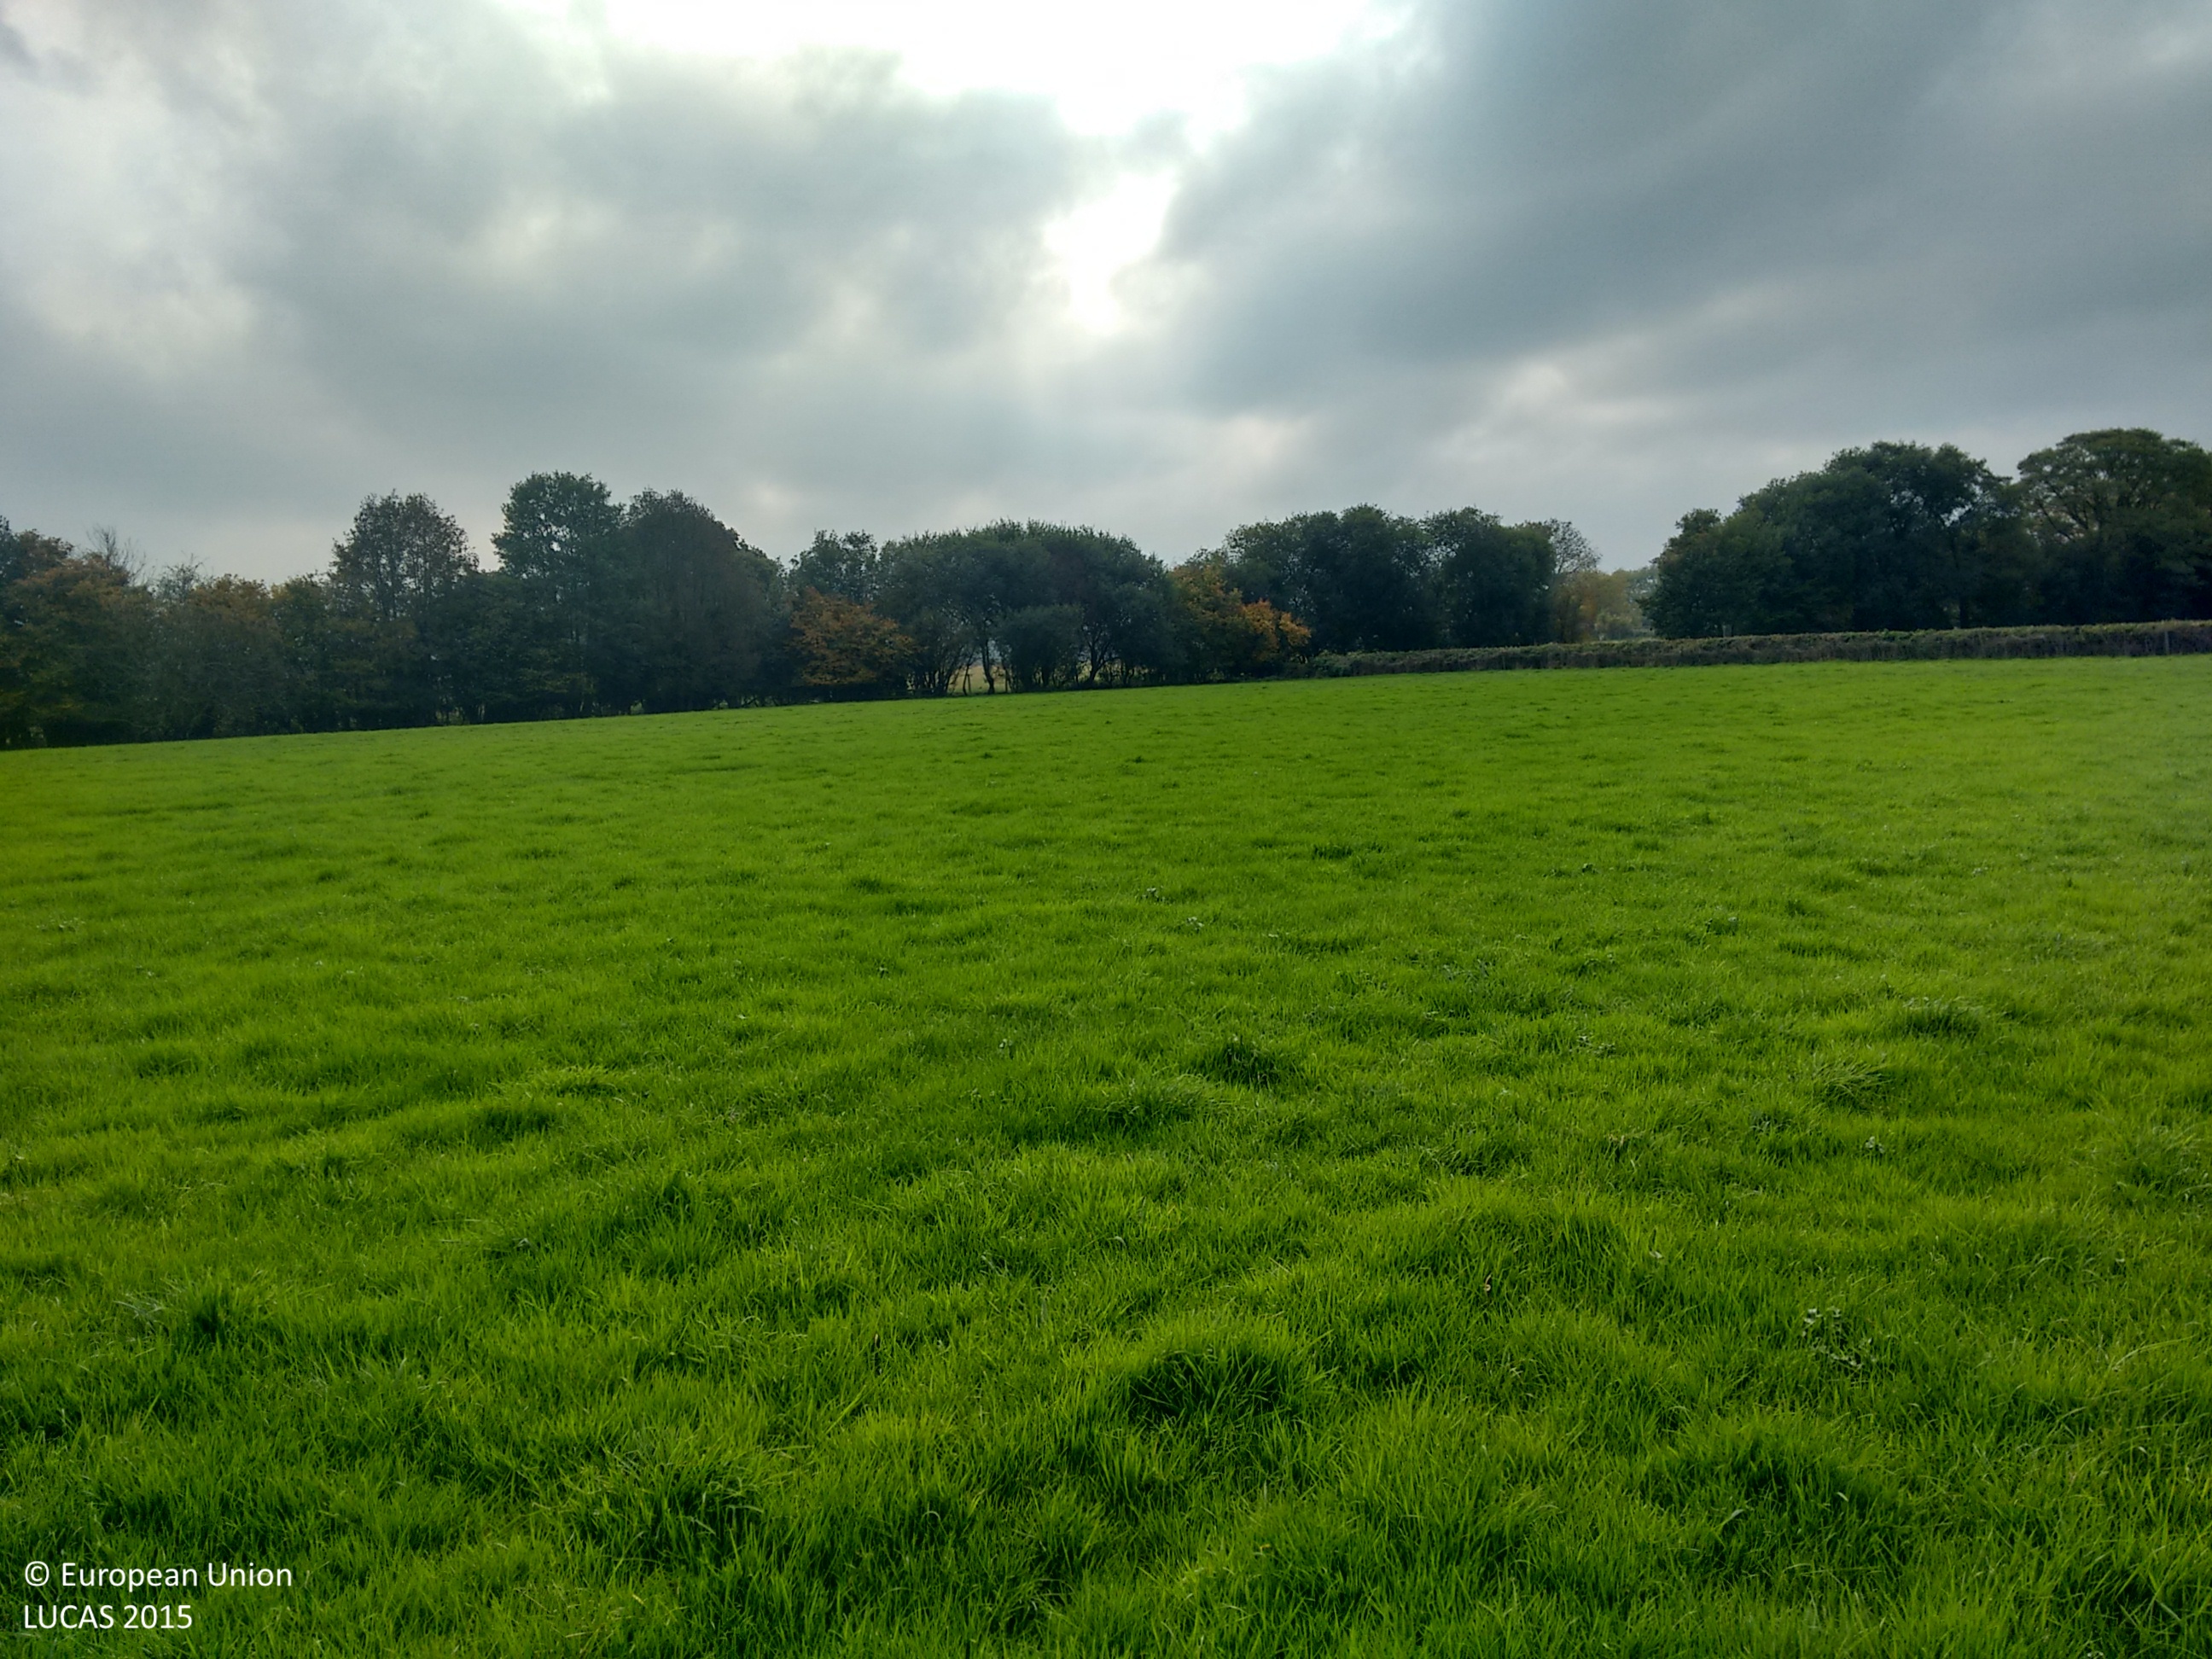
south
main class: Grassland
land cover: Grassland without tree/shrub cover
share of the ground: > 75 %
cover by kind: herbaceous plants 100 %
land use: Agriculture (excluding fallow land and kitchen gardens)
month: October
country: GB
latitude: 52.5936
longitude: -2.7813
